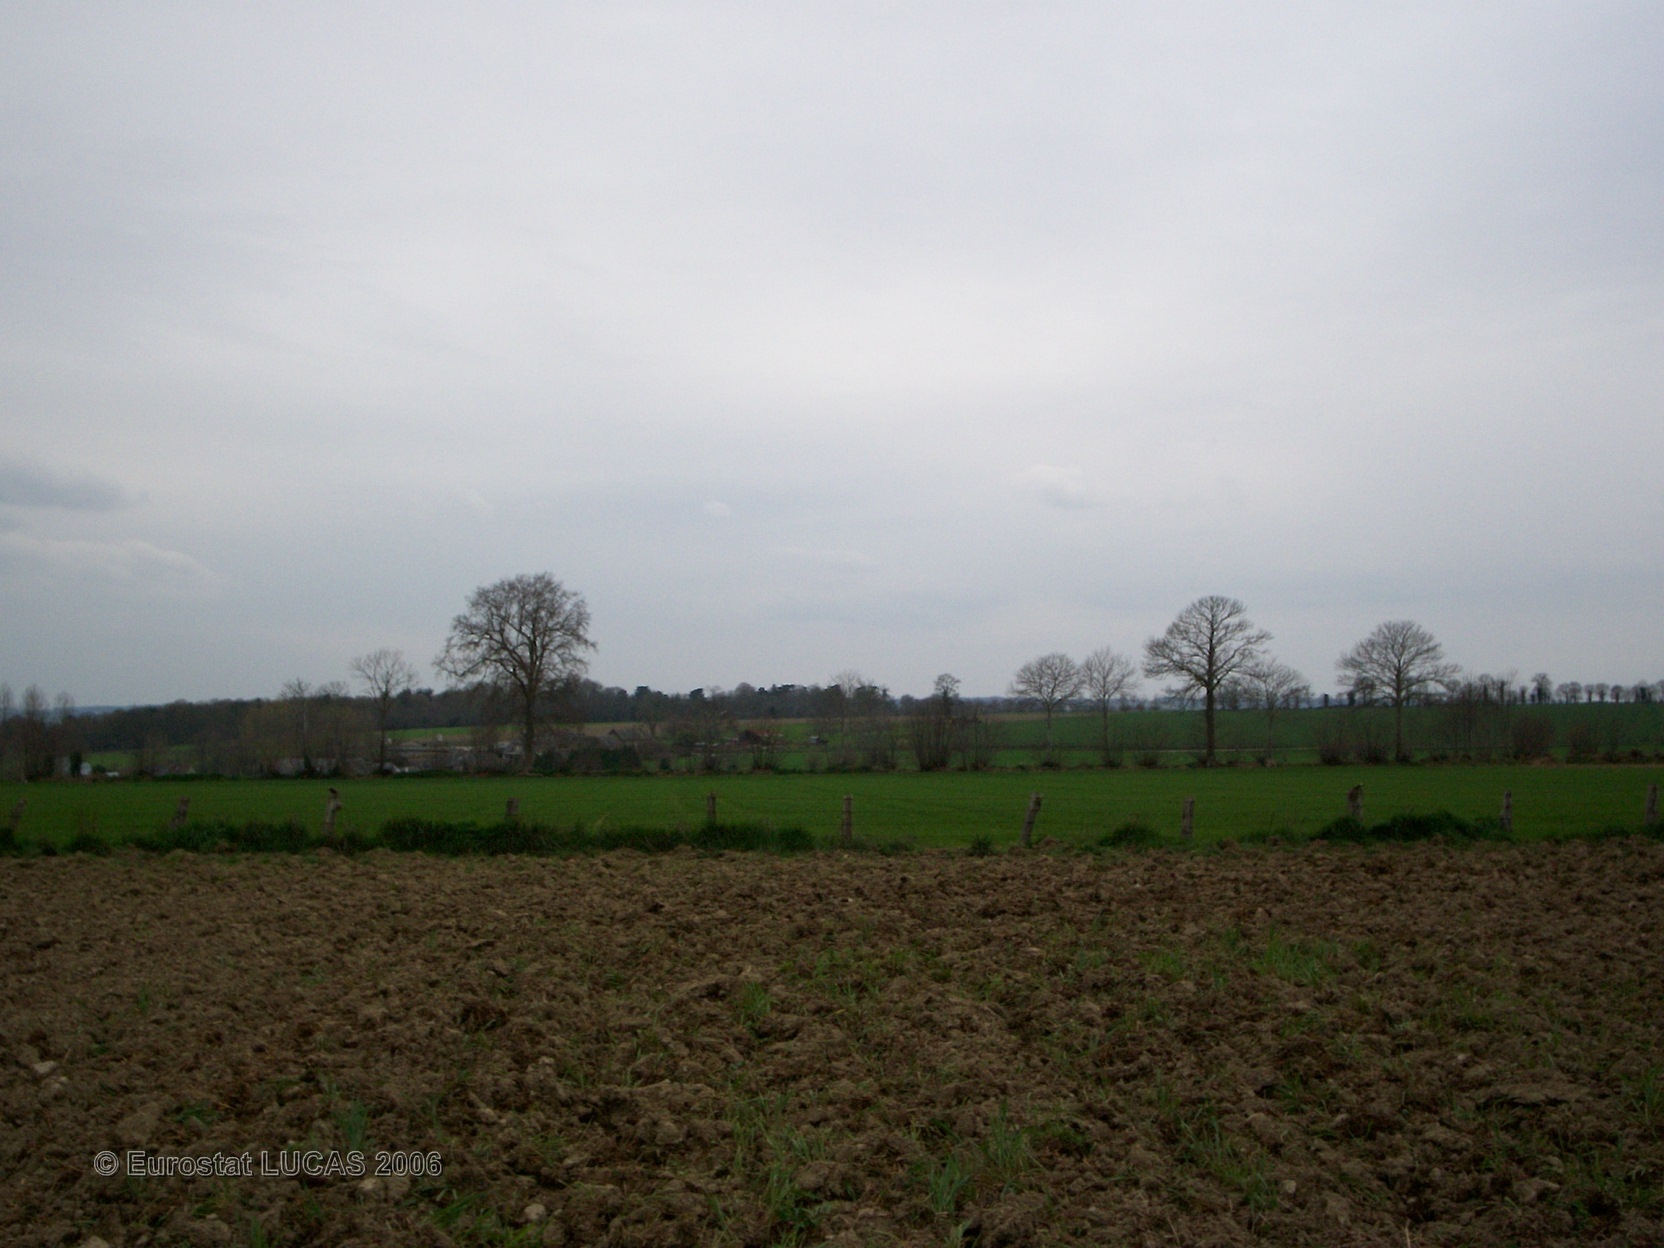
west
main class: Cropland
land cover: Maize
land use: Agriculture (excluding fallow land and kitchen gardens)
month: April
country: FR
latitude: 48.4816
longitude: -1.4237
